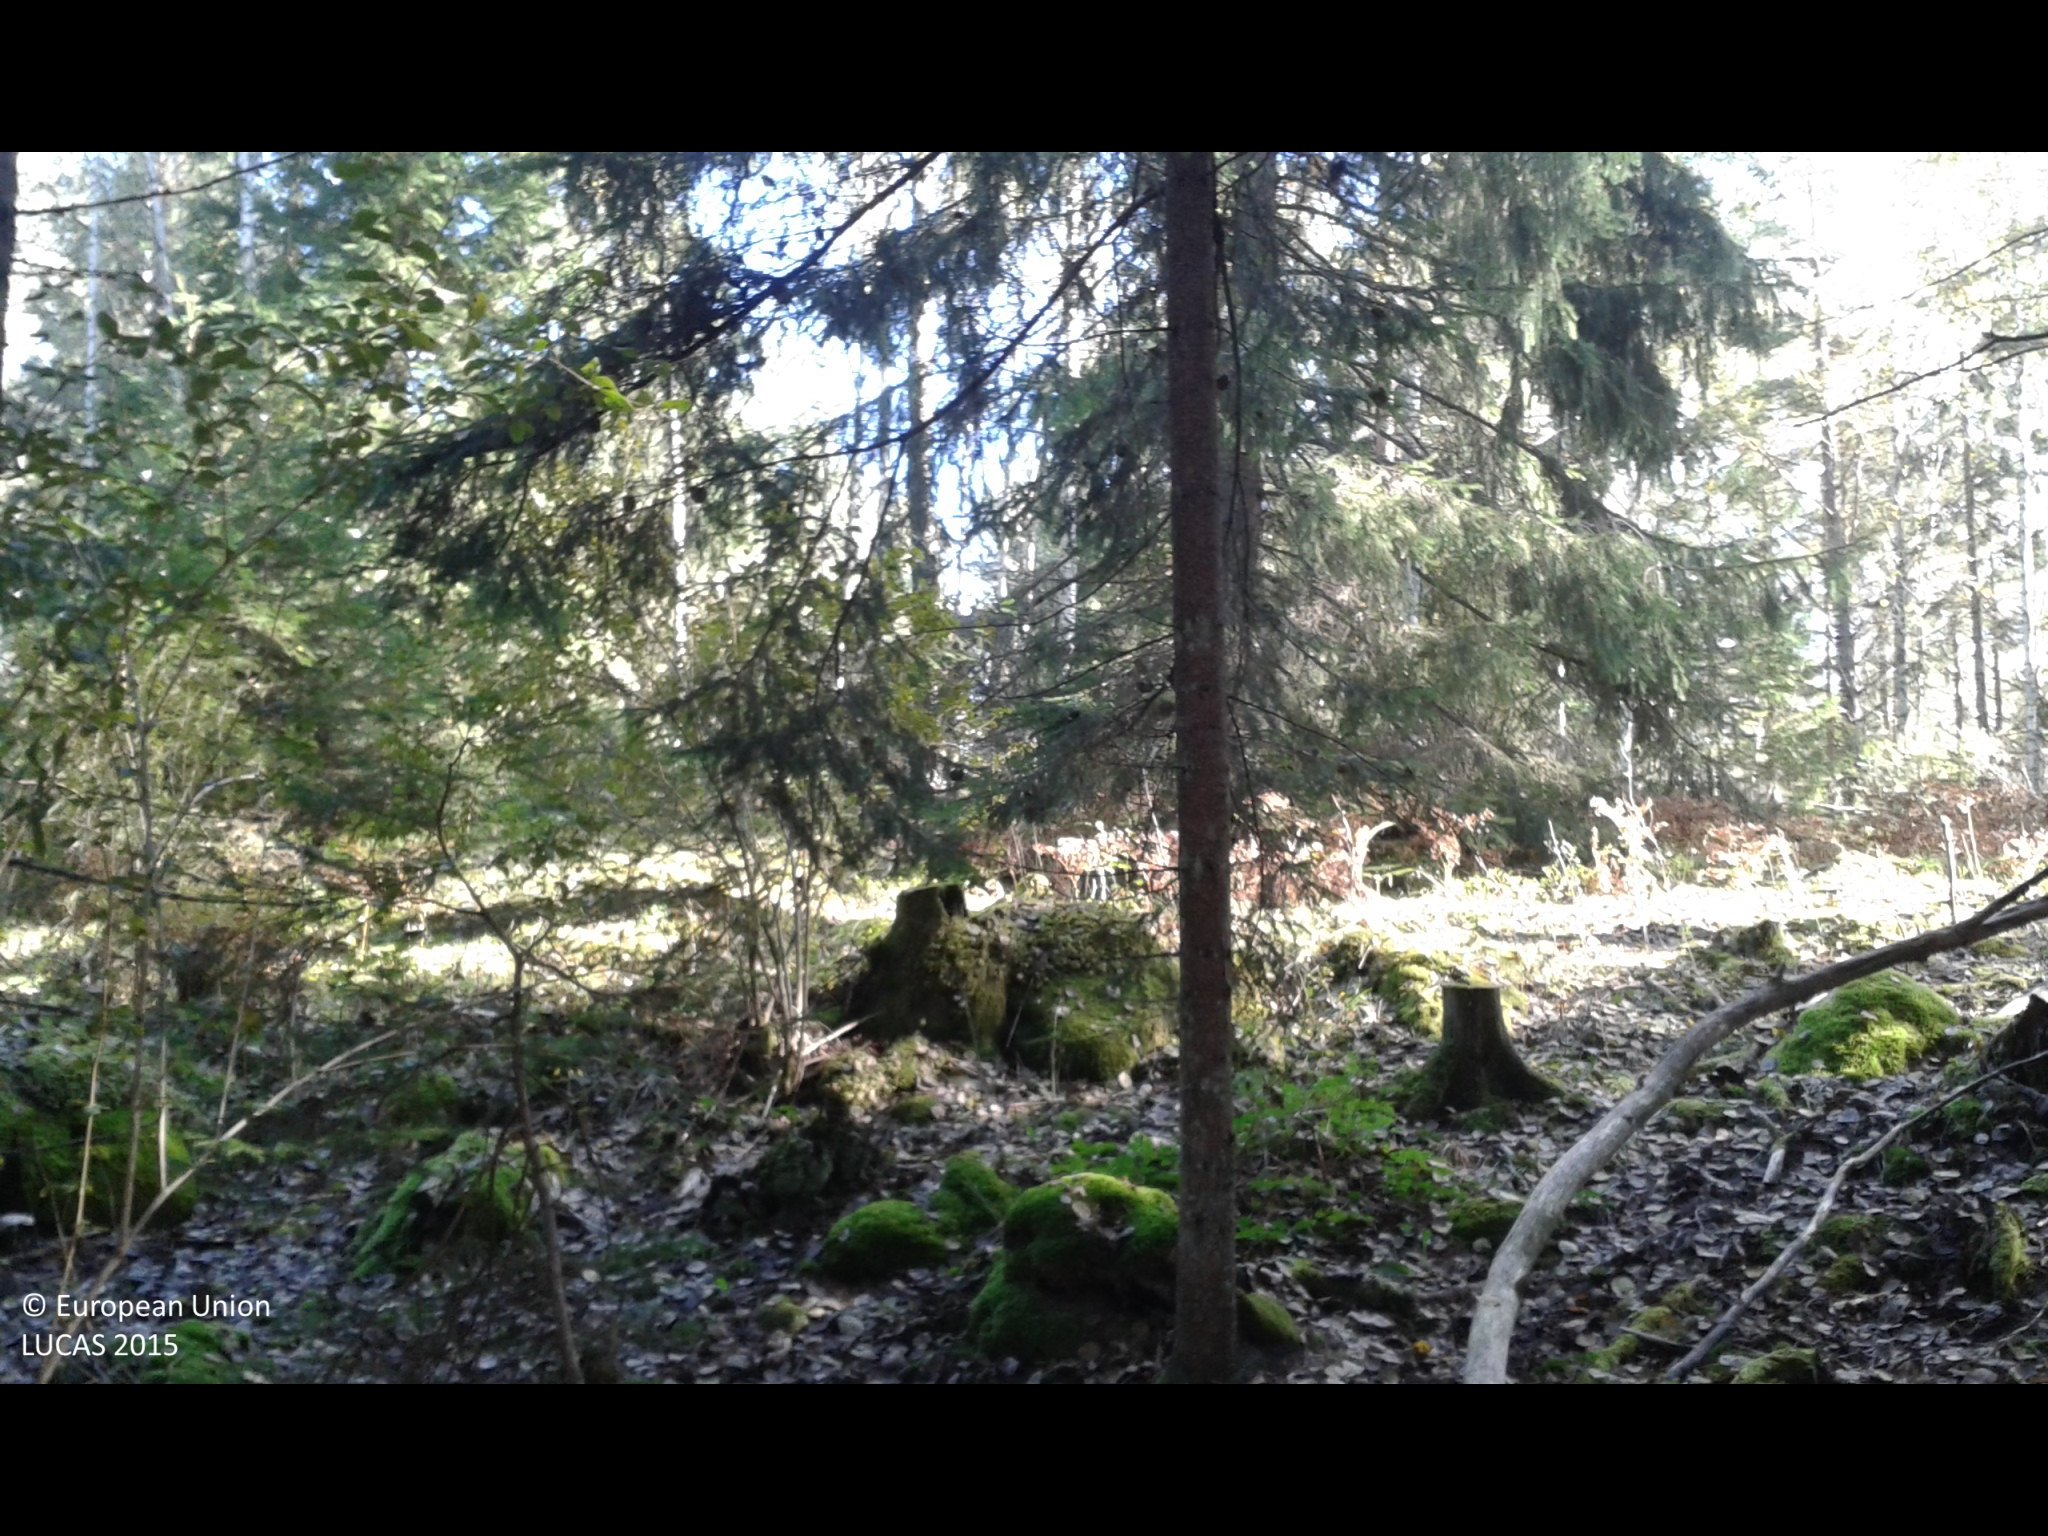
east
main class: Woodland
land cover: Spruce dominated coniferous woodland
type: boreal forest
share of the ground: > 75 %
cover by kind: coniferous forest trees 70 %, broadleaved forest trees 10 %, herbaceous plants 10 %, lichens and mosses 10 %
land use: Forestry
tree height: > 5 m
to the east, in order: Spruce dominated coniferous woodland; Ditches and canals; Spruce dominated coniferous woodland; Spruce dominated mixed woodland; Tracks; Pine dominated mixed woodland
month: September
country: SE
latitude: 59.0277
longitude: 17.4012
